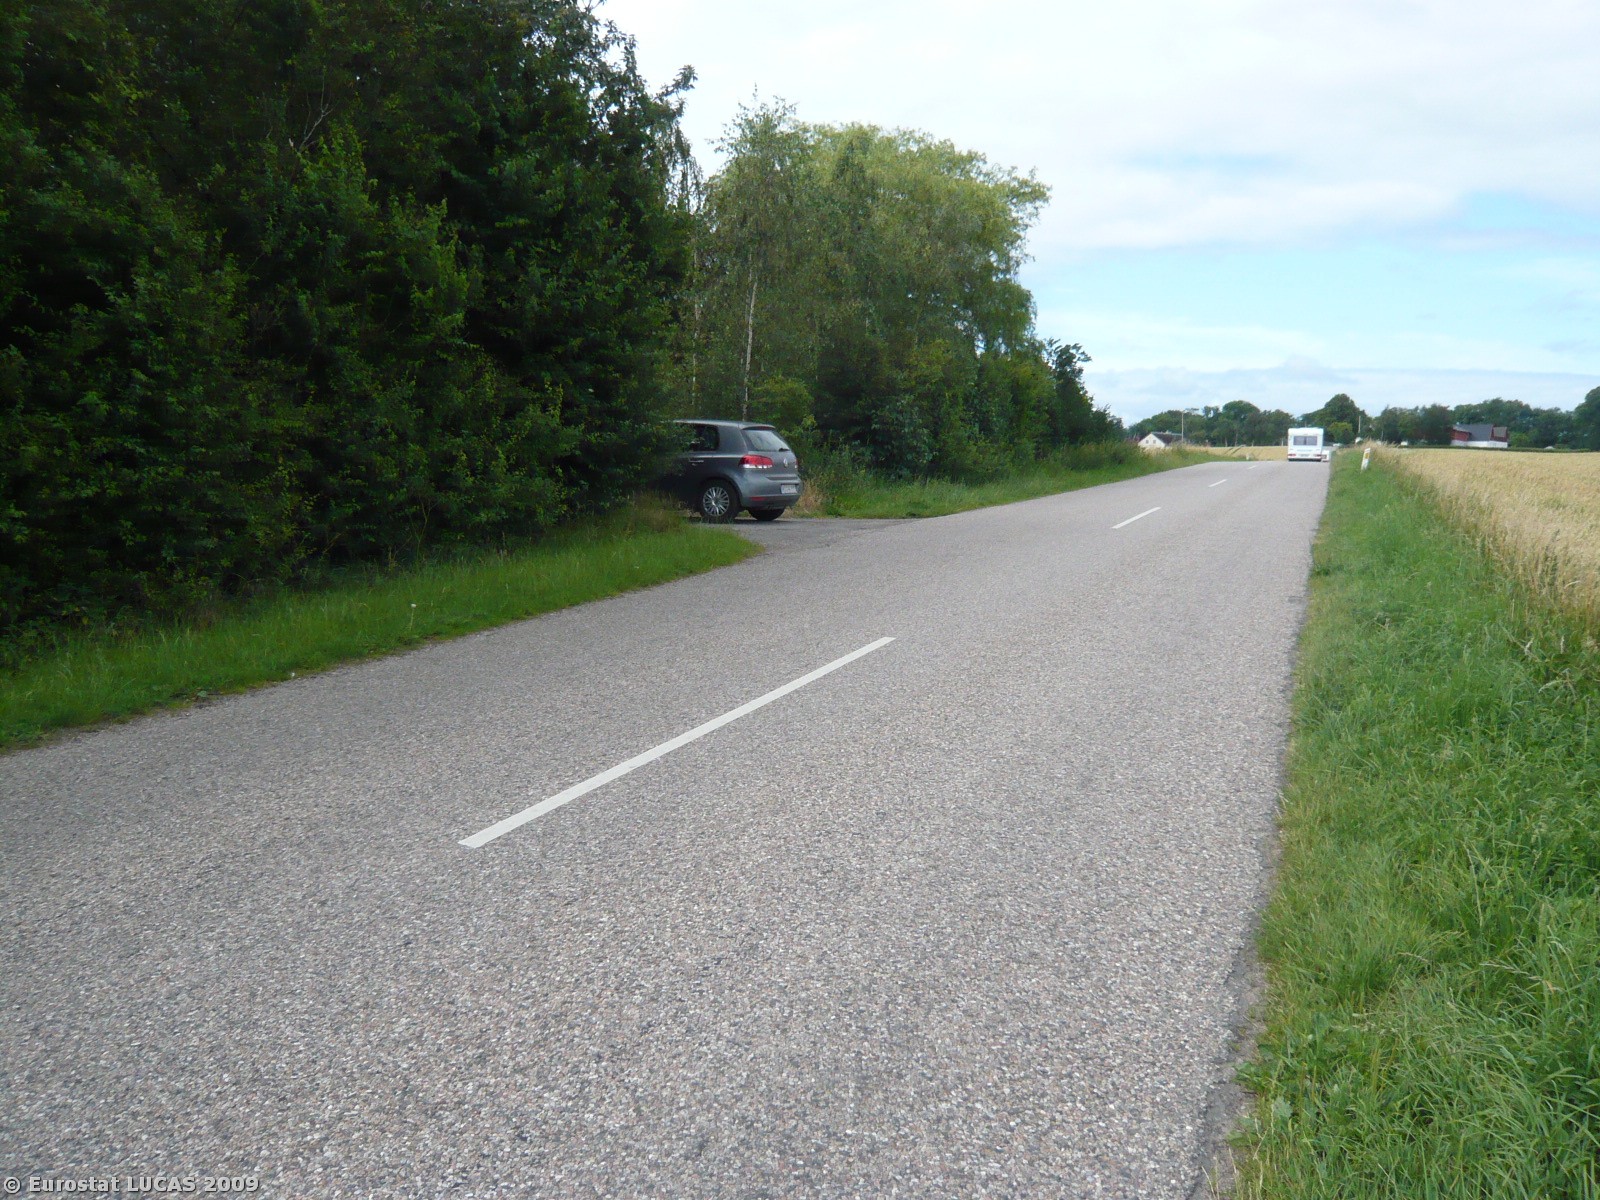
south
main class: Cropland
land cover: Common wheat
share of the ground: > 75 %
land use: Agriculture (excluding fallow land and kitchen gardens)
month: July
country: DK
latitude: 55.5884
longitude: 11.2523
